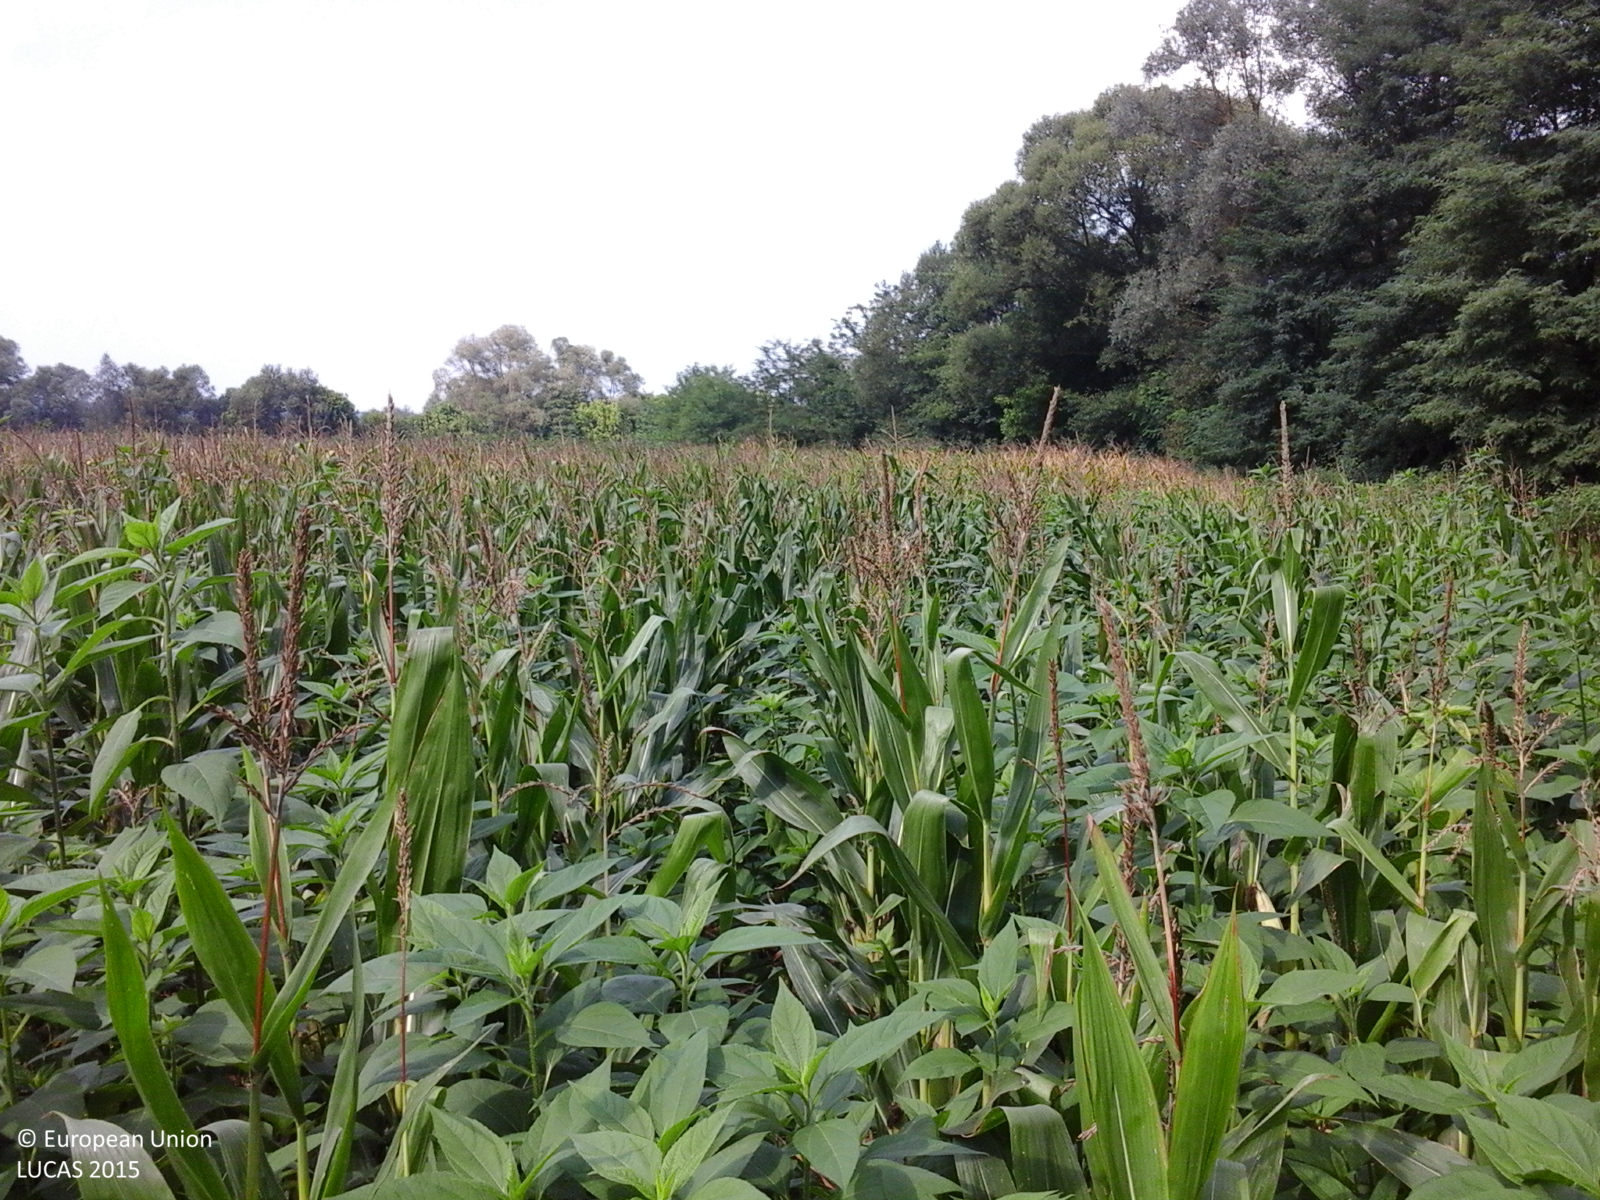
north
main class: Cropland
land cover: Maize
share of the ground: > 75 %
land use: Agriculture (excluding fallow land and kitchen gardens)
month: August
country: RO
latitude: 46.3040
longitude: 22.2119
